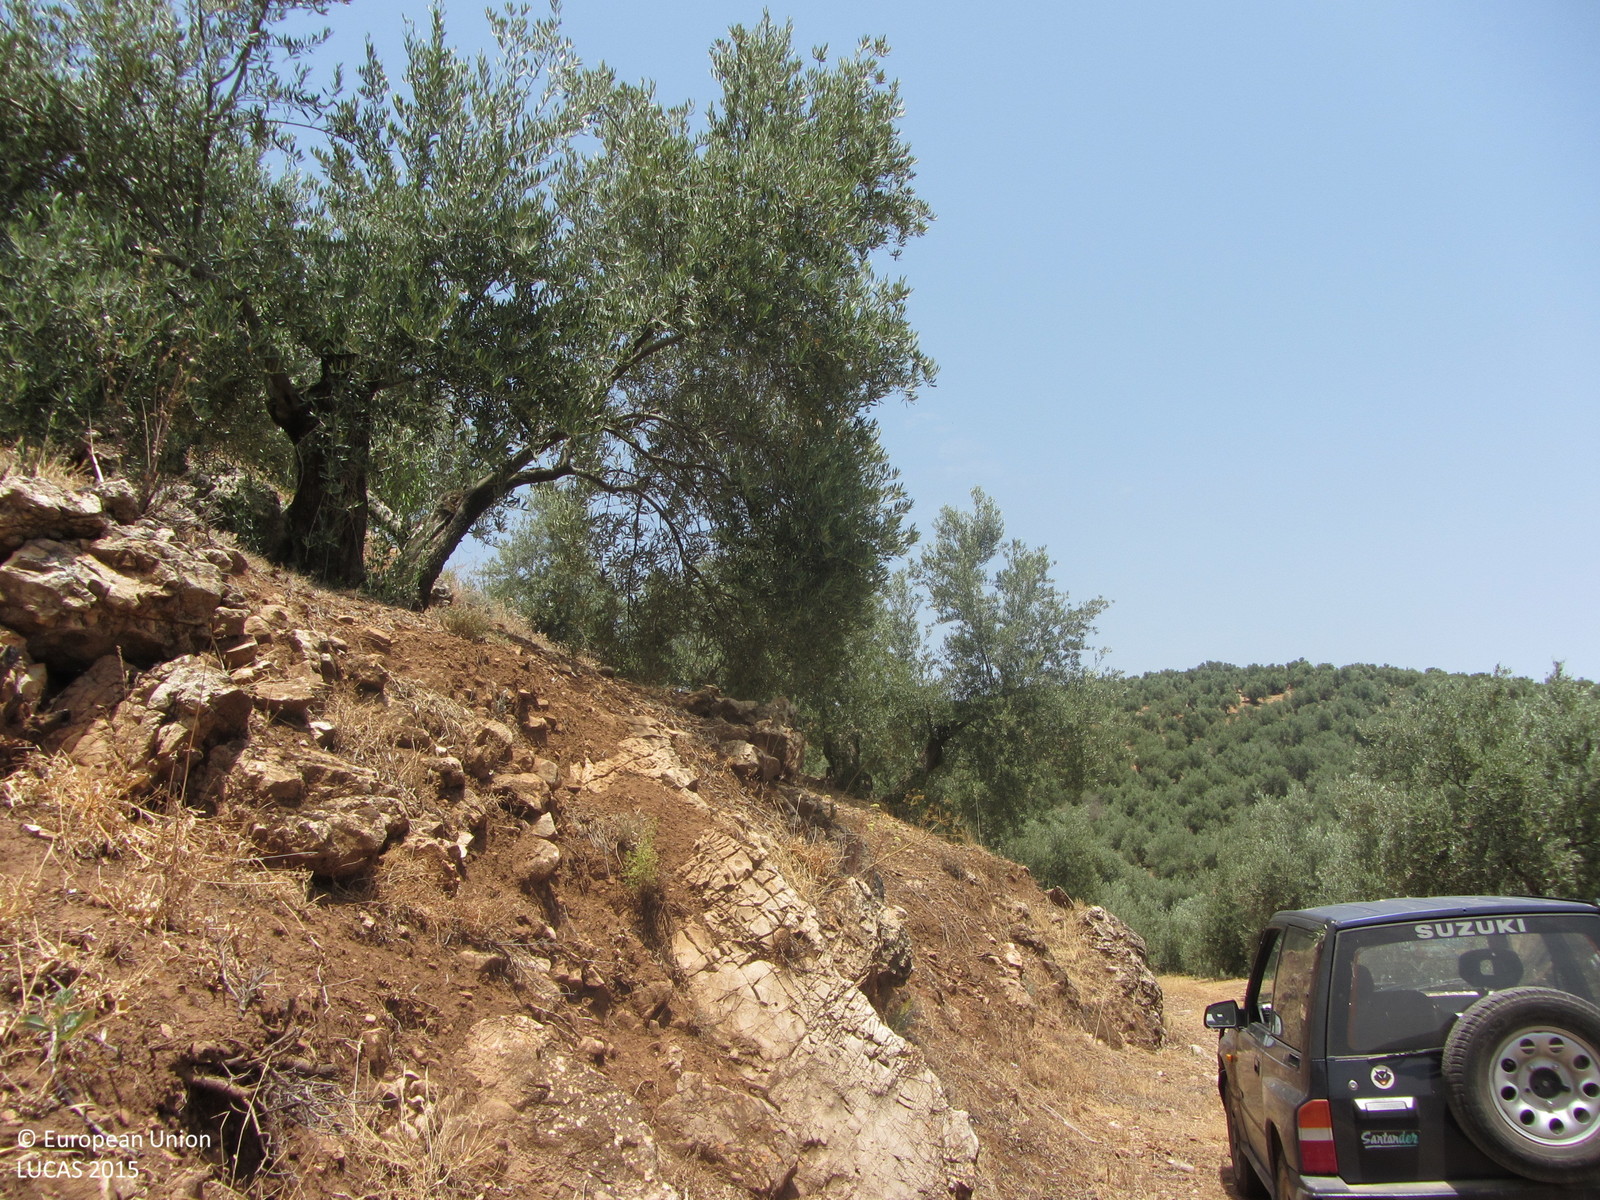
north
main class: Cropland
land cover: Olive groves
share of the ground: 25 - 50 %
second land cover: Other bare soil
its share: > 75 %
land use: Agriculture (excluding fallow land and kitchen gardens)
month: July
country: ES
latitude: 38.3207
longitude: -2.8444
